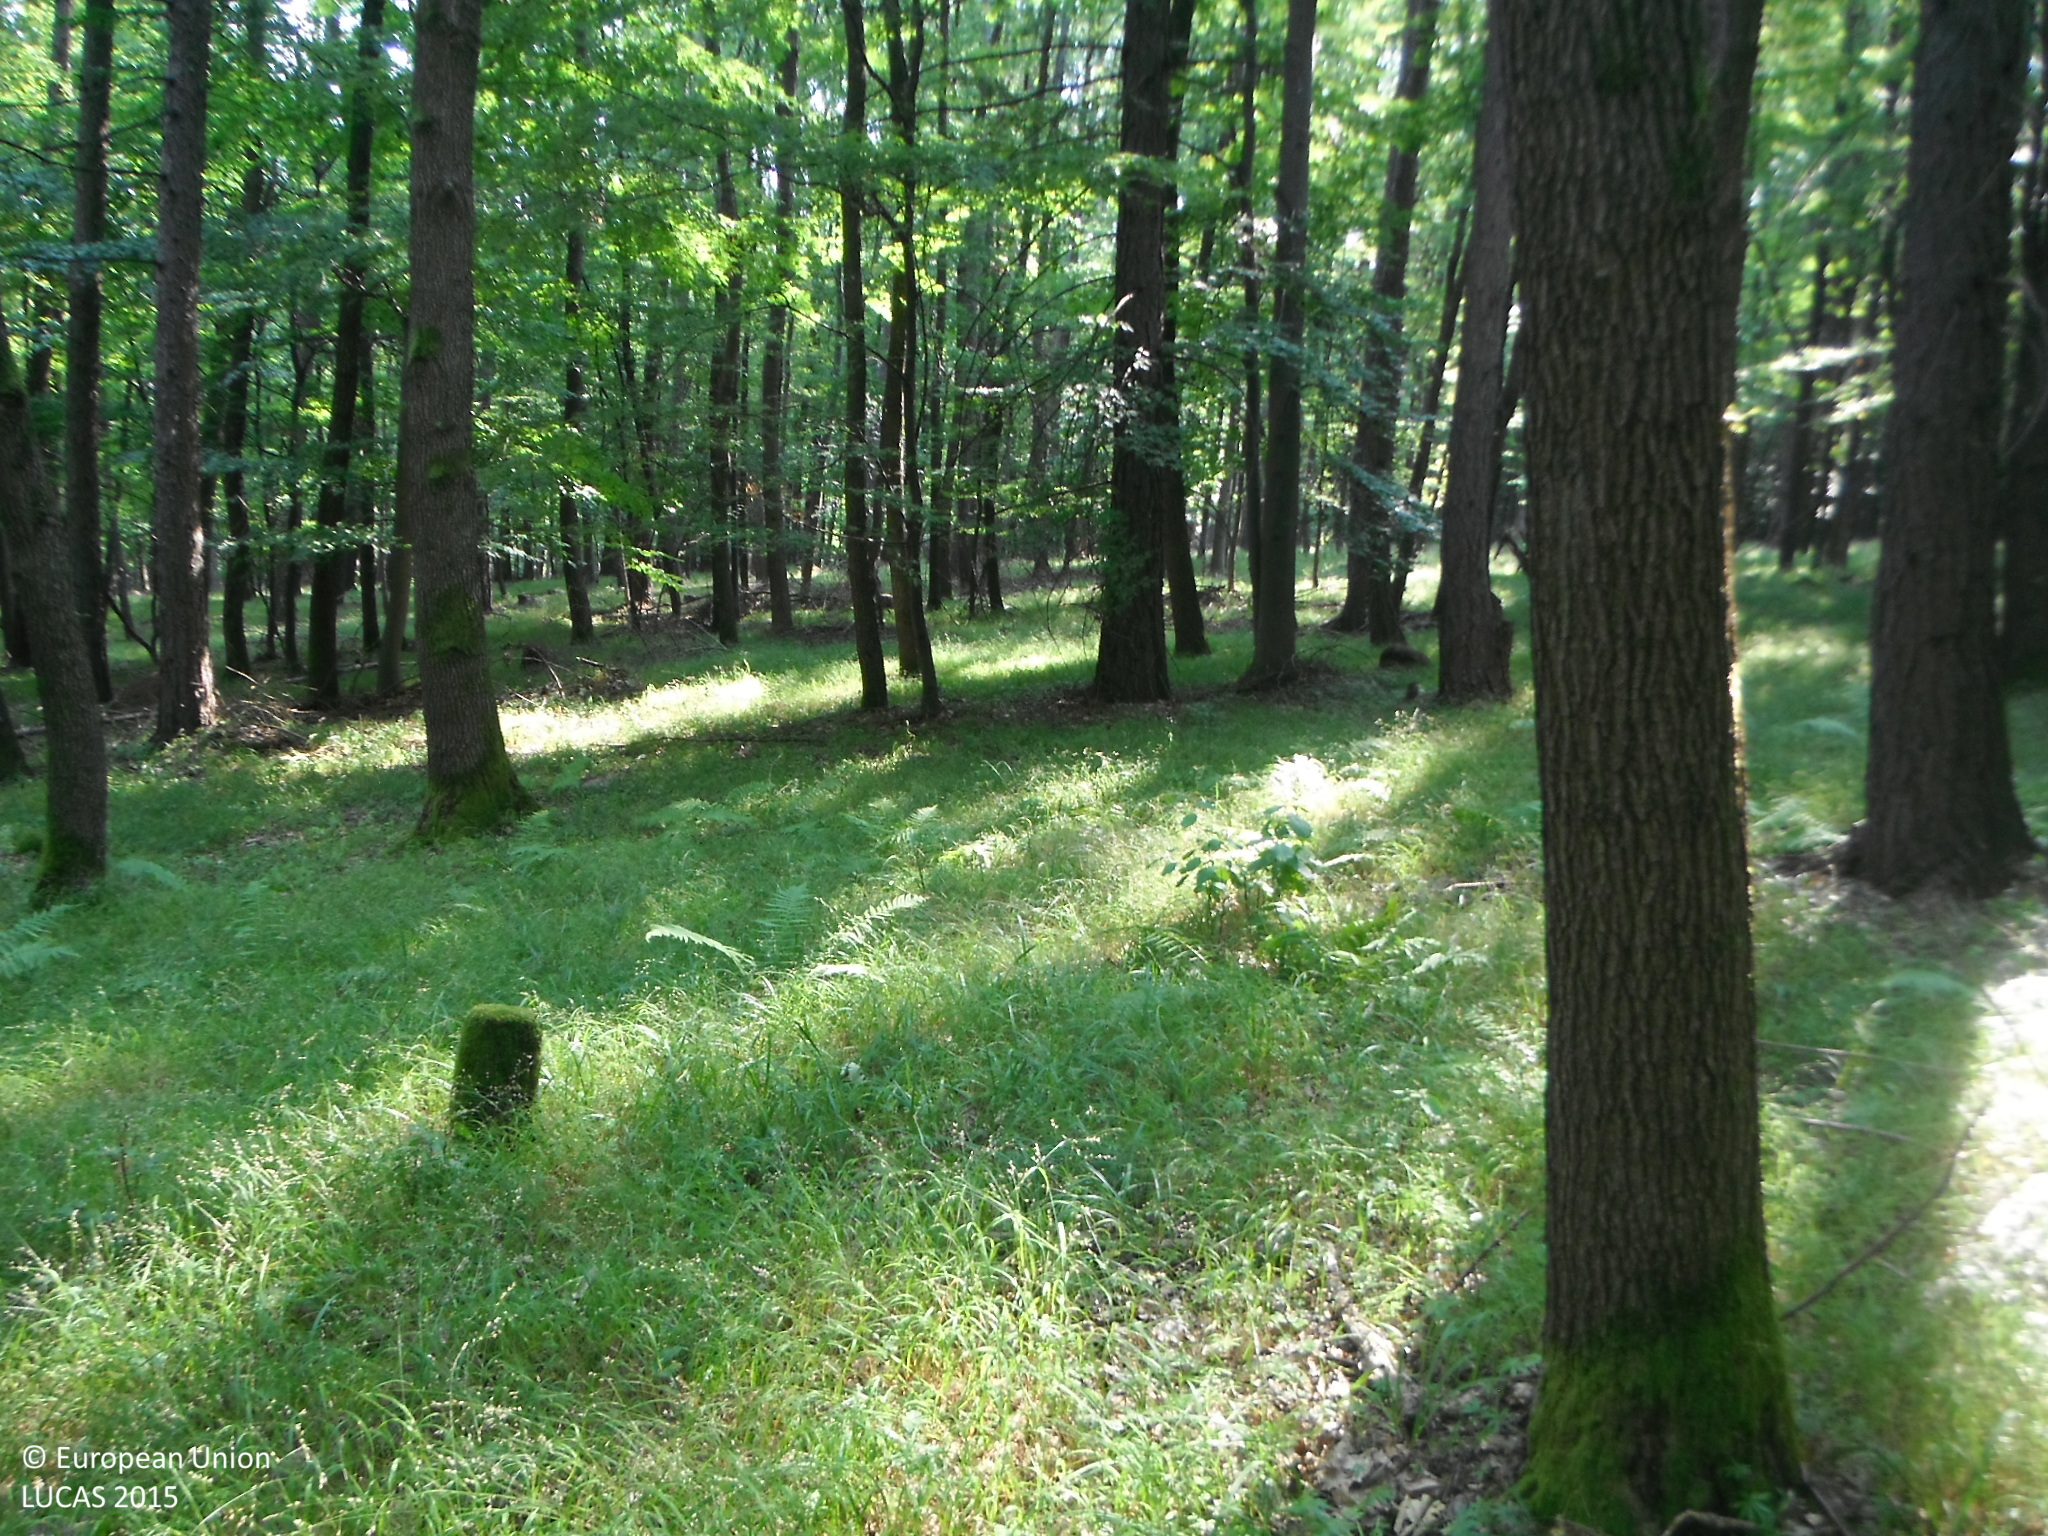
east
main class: Woodland
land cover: Broadleaved woodland
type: acidophilous oak and oak-birch forest
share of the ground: > 75 %
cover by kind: broadleaved forest trees 90 %, coniferous forest trees 5 %, herbaceous plants 5 %
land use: Forestry
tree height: > 5 m
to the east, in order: Broadleaved woodland; Other mixed woodland; Tracks; Other mixed woodland; Broadleaved woodland; Tracks; Spruce dominated mixed woodland; Broadleaved woodland
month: August
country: SK
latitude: 48.7385
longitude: 18.1053
